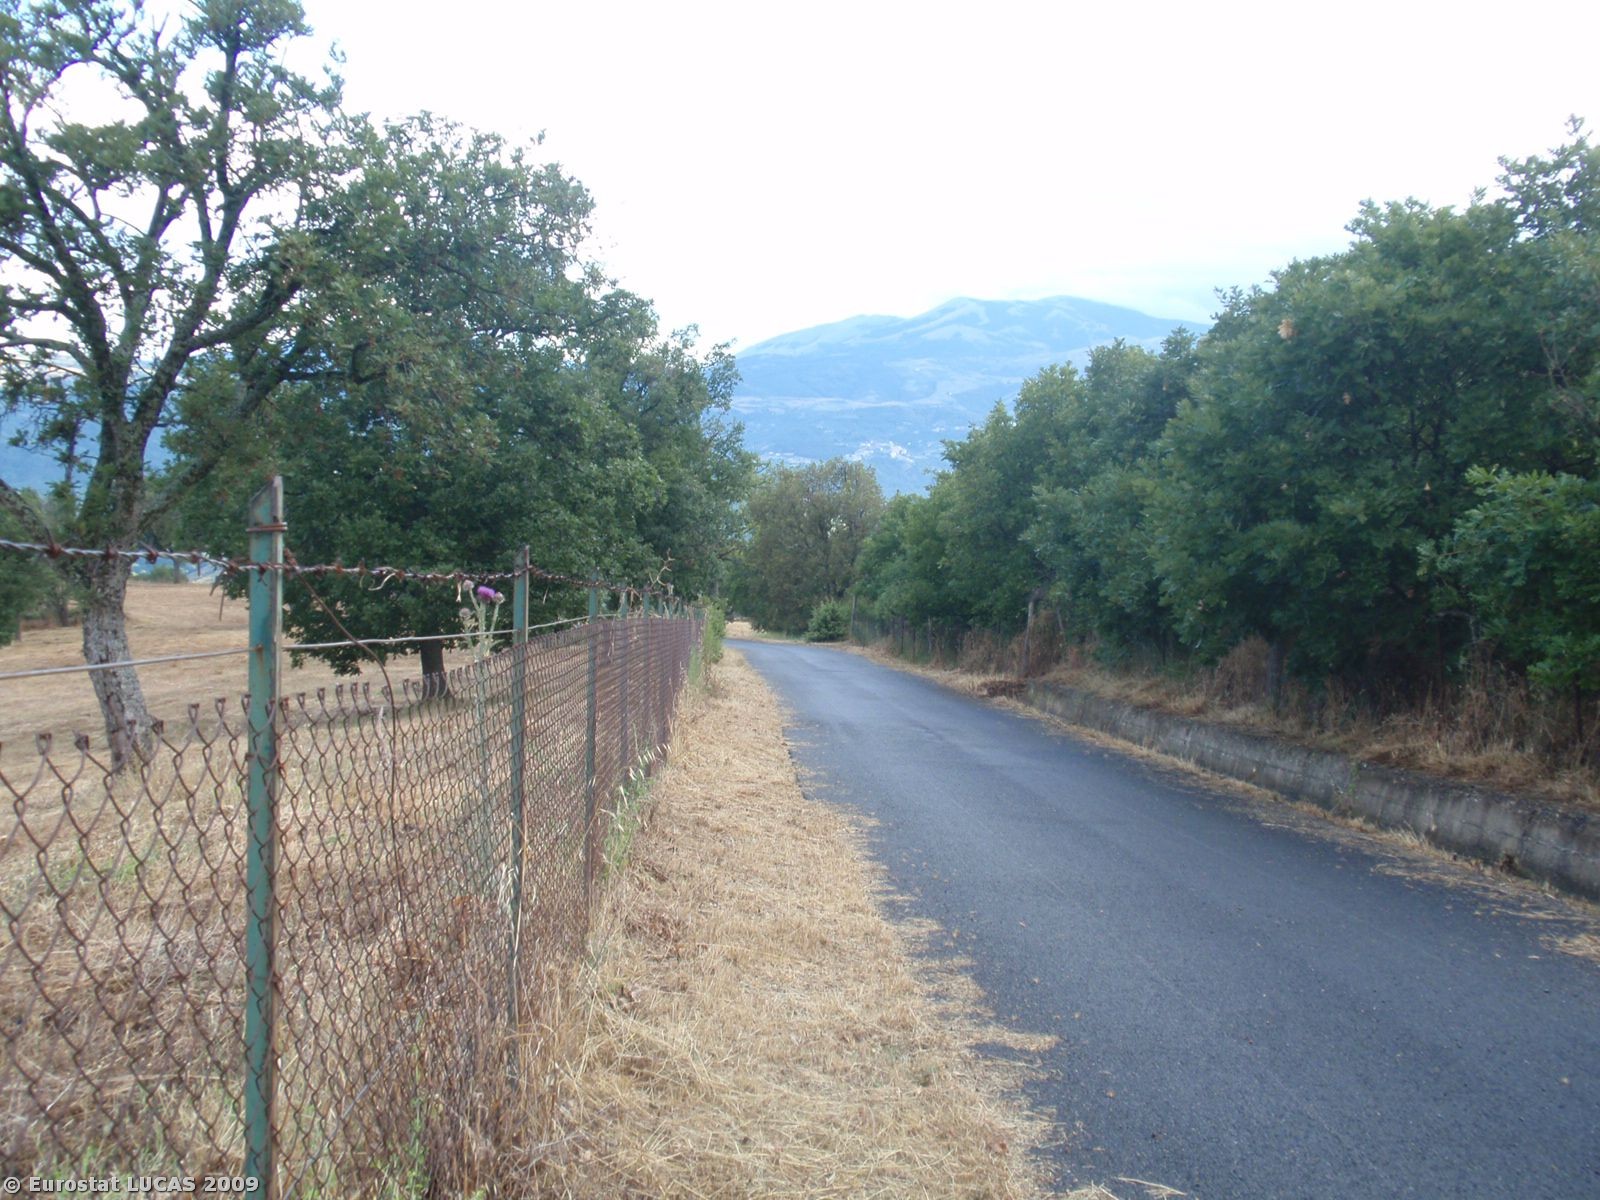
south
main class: Cropland
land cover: Temporary grasslands
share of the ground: < 10 %
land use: Agriculture (excluding fallow land and kitchen gardens)
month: June
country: IT
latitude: 40.2768
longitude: 16.1027
